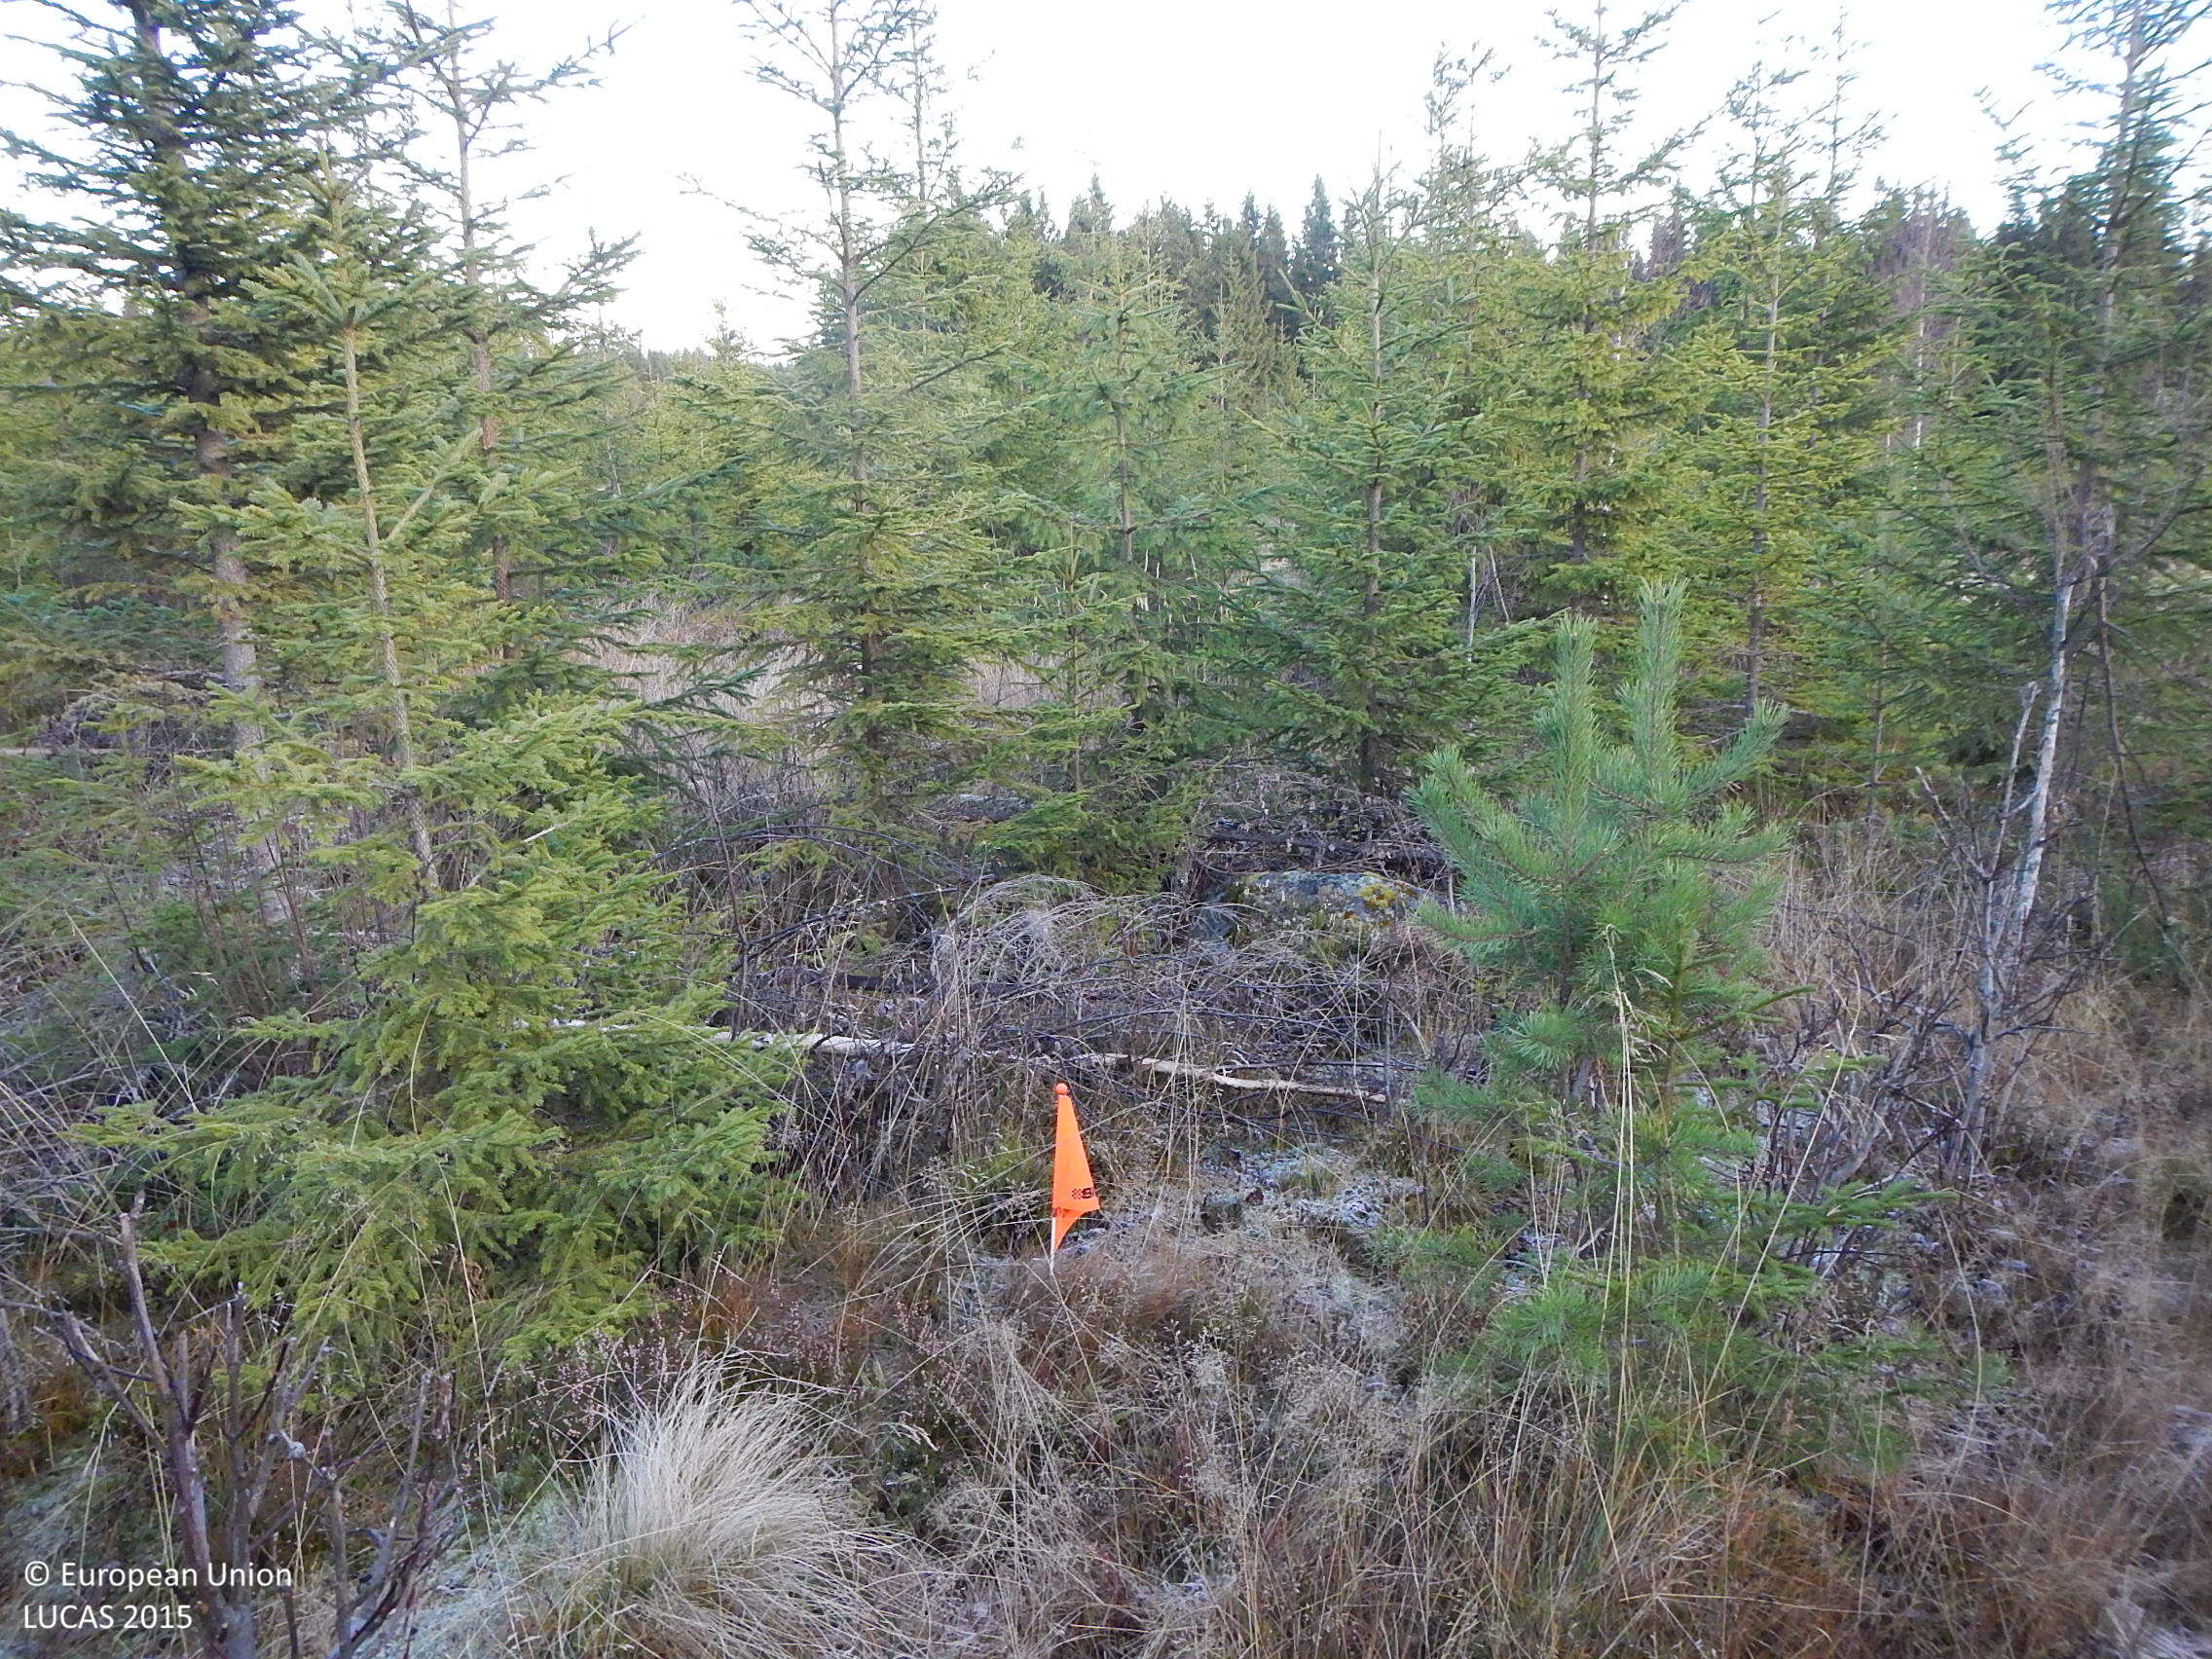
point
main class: Woodland
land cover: Spruce dominated coniferous woodland
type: boreal forest
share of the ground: 25 - 50 %
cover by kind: coniferous forest trees 40 %, shrubs 25 %, herbaceous plants 25 %, lichens and mosses 10 %
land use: Forestry
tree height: < 5 m
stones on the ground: < 10 %
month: November
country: SE
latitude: 61.5649
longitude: 16.1397
